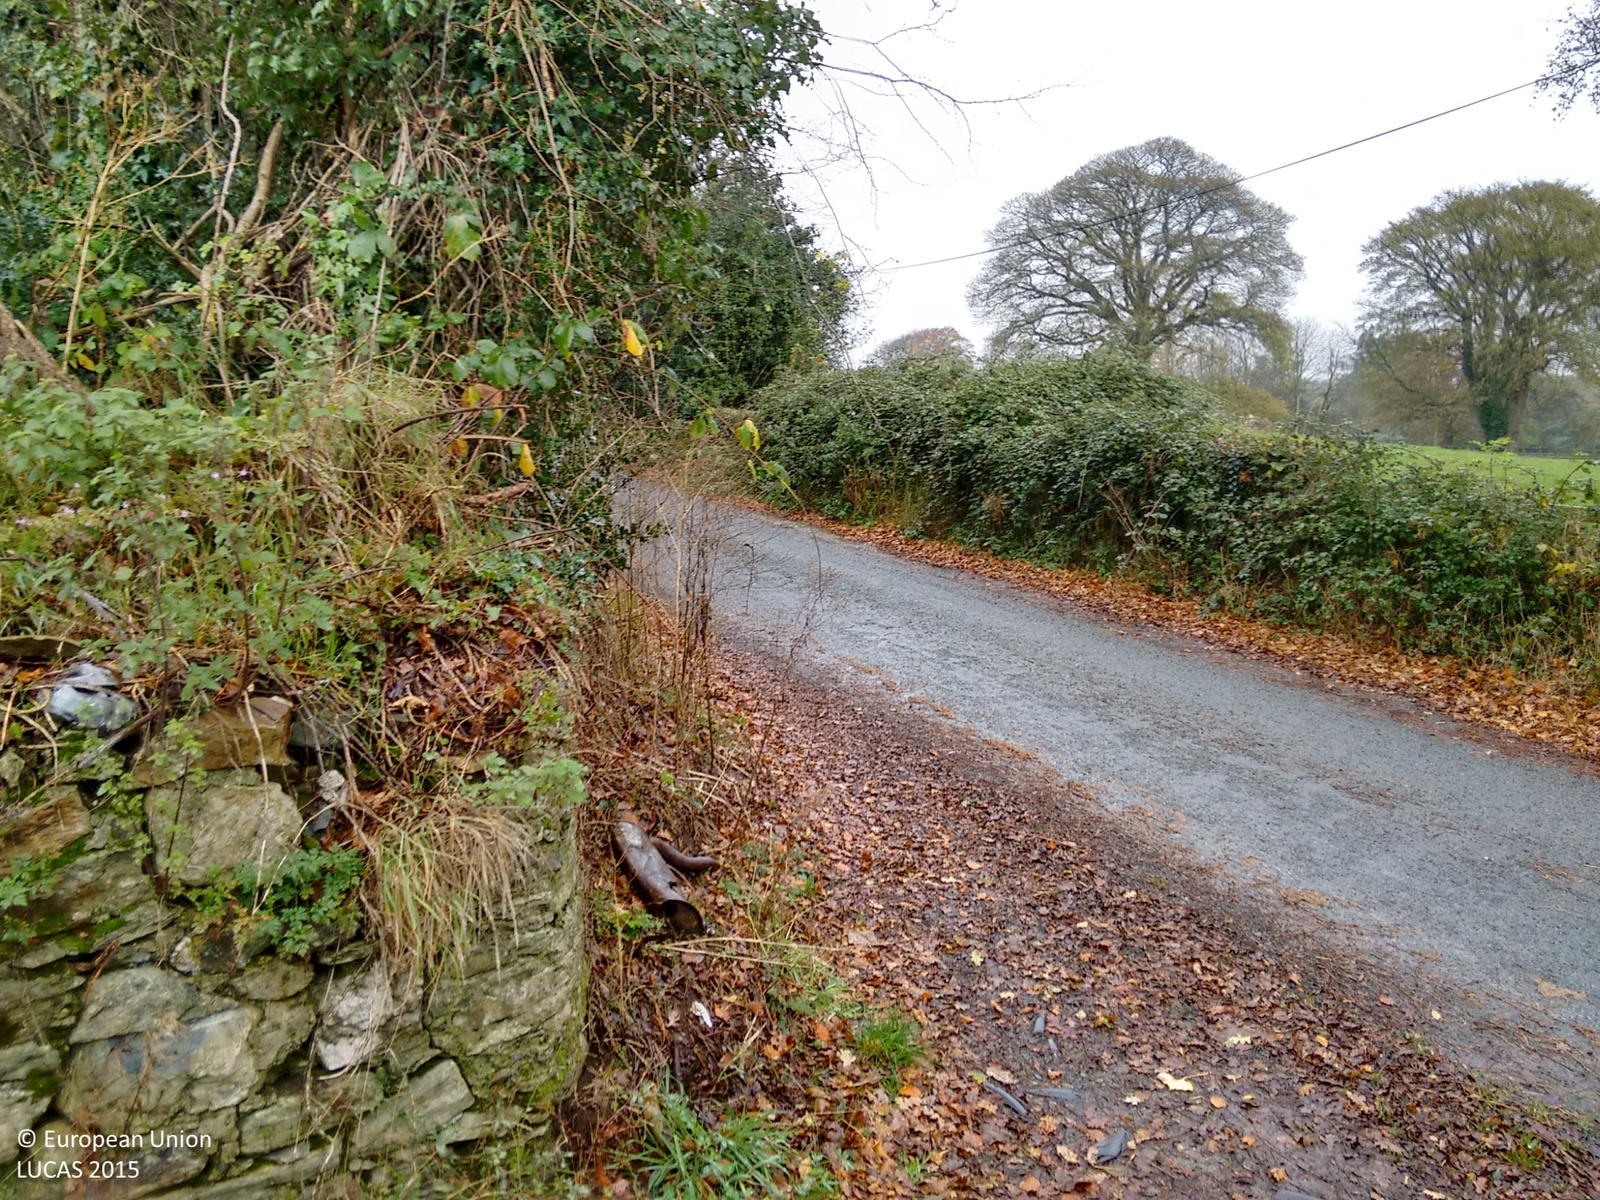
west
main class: Grassland
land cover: Grassland without tree/shrub cover
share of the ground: > 75 %
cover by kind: herbaceous plants 60 %
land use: Agriculture (excluding fallow land and kitchen gardens)
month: November
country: IE
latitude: 53.0671
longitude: -6.0990
